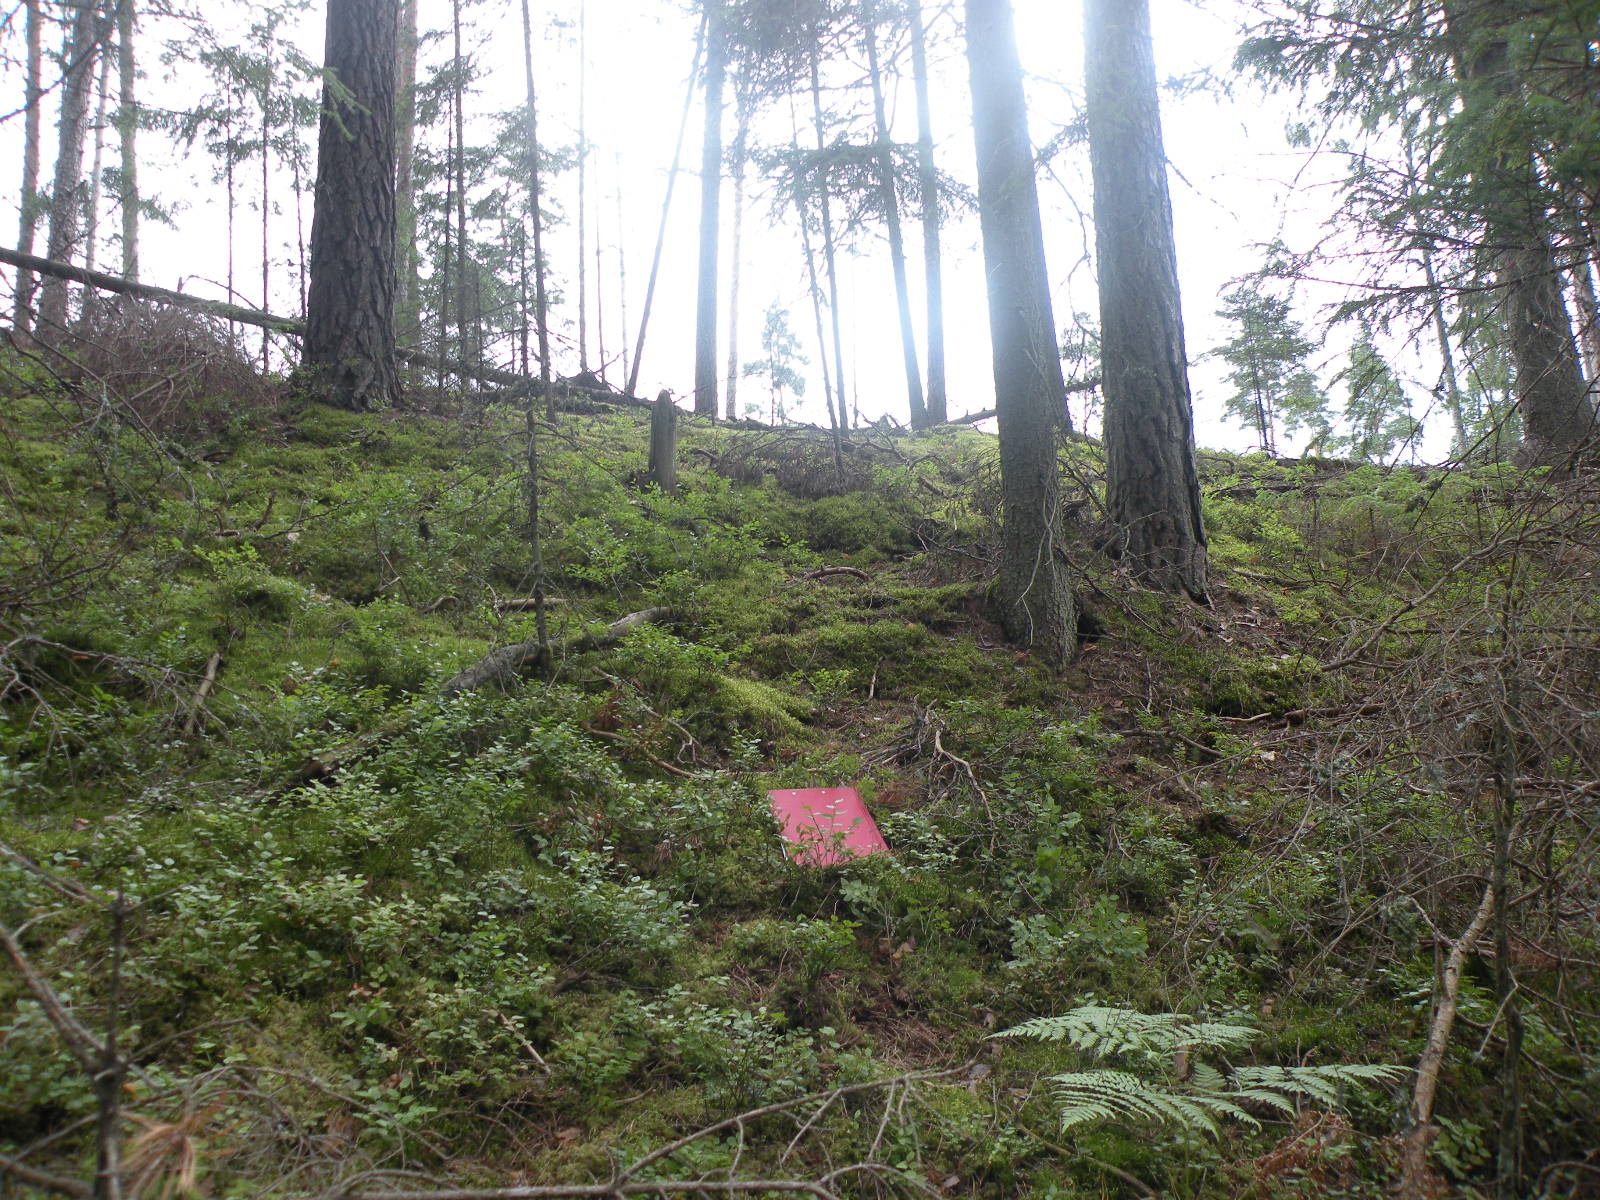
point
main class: Woodland
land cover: Other coniferous woodland
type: hemiboreal forest and nemoral coniferous forest and mixed broadleaved-coniferous forest
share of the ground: > 75 %
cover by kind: coniferous forest trees 80 %, lichens and mosses 10 %, shrubs 5 %, herbaceous plants 5 %
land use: Forestry
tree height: > 5 m
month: July
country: LV
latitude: 55.8323
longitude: 27.2740
